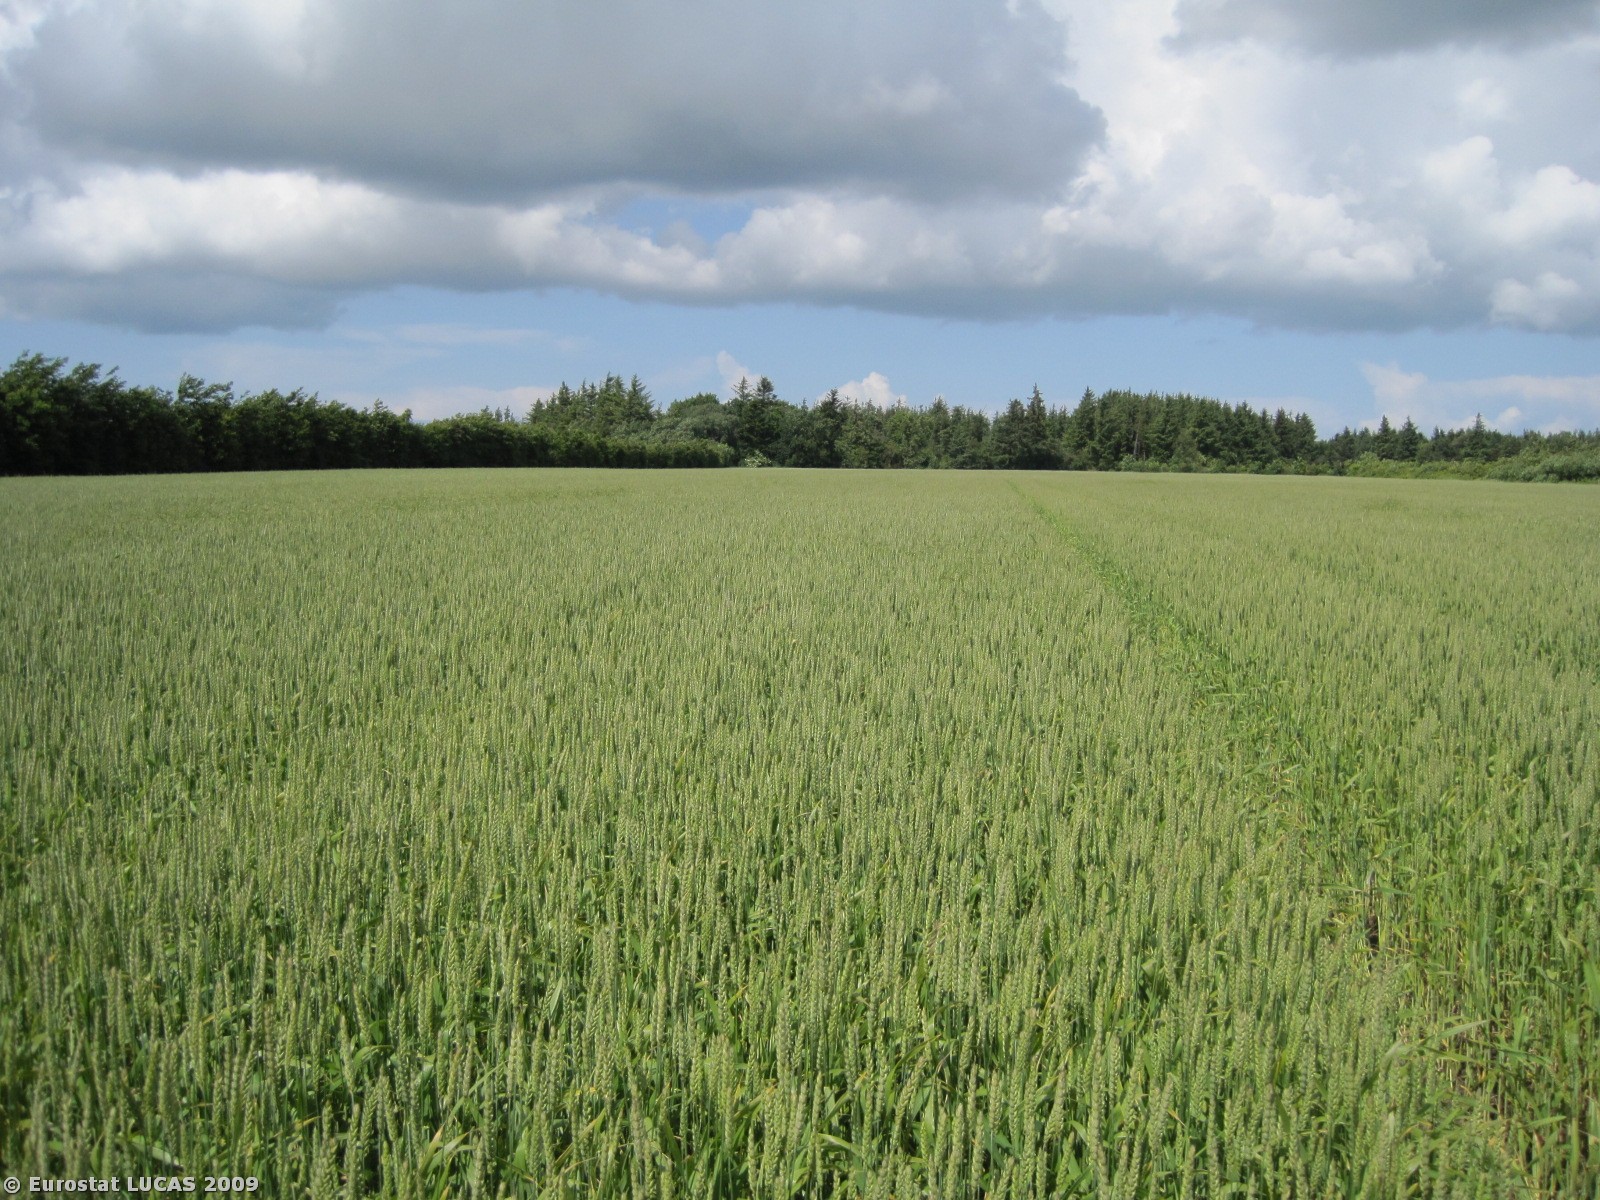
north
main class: Cropland
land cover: Common wheat
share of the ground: > 75 %
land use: Agriculture (excluding fallow land and kitchen gardens)
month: June
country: DK
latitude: 57.0661
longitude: 9.1931
